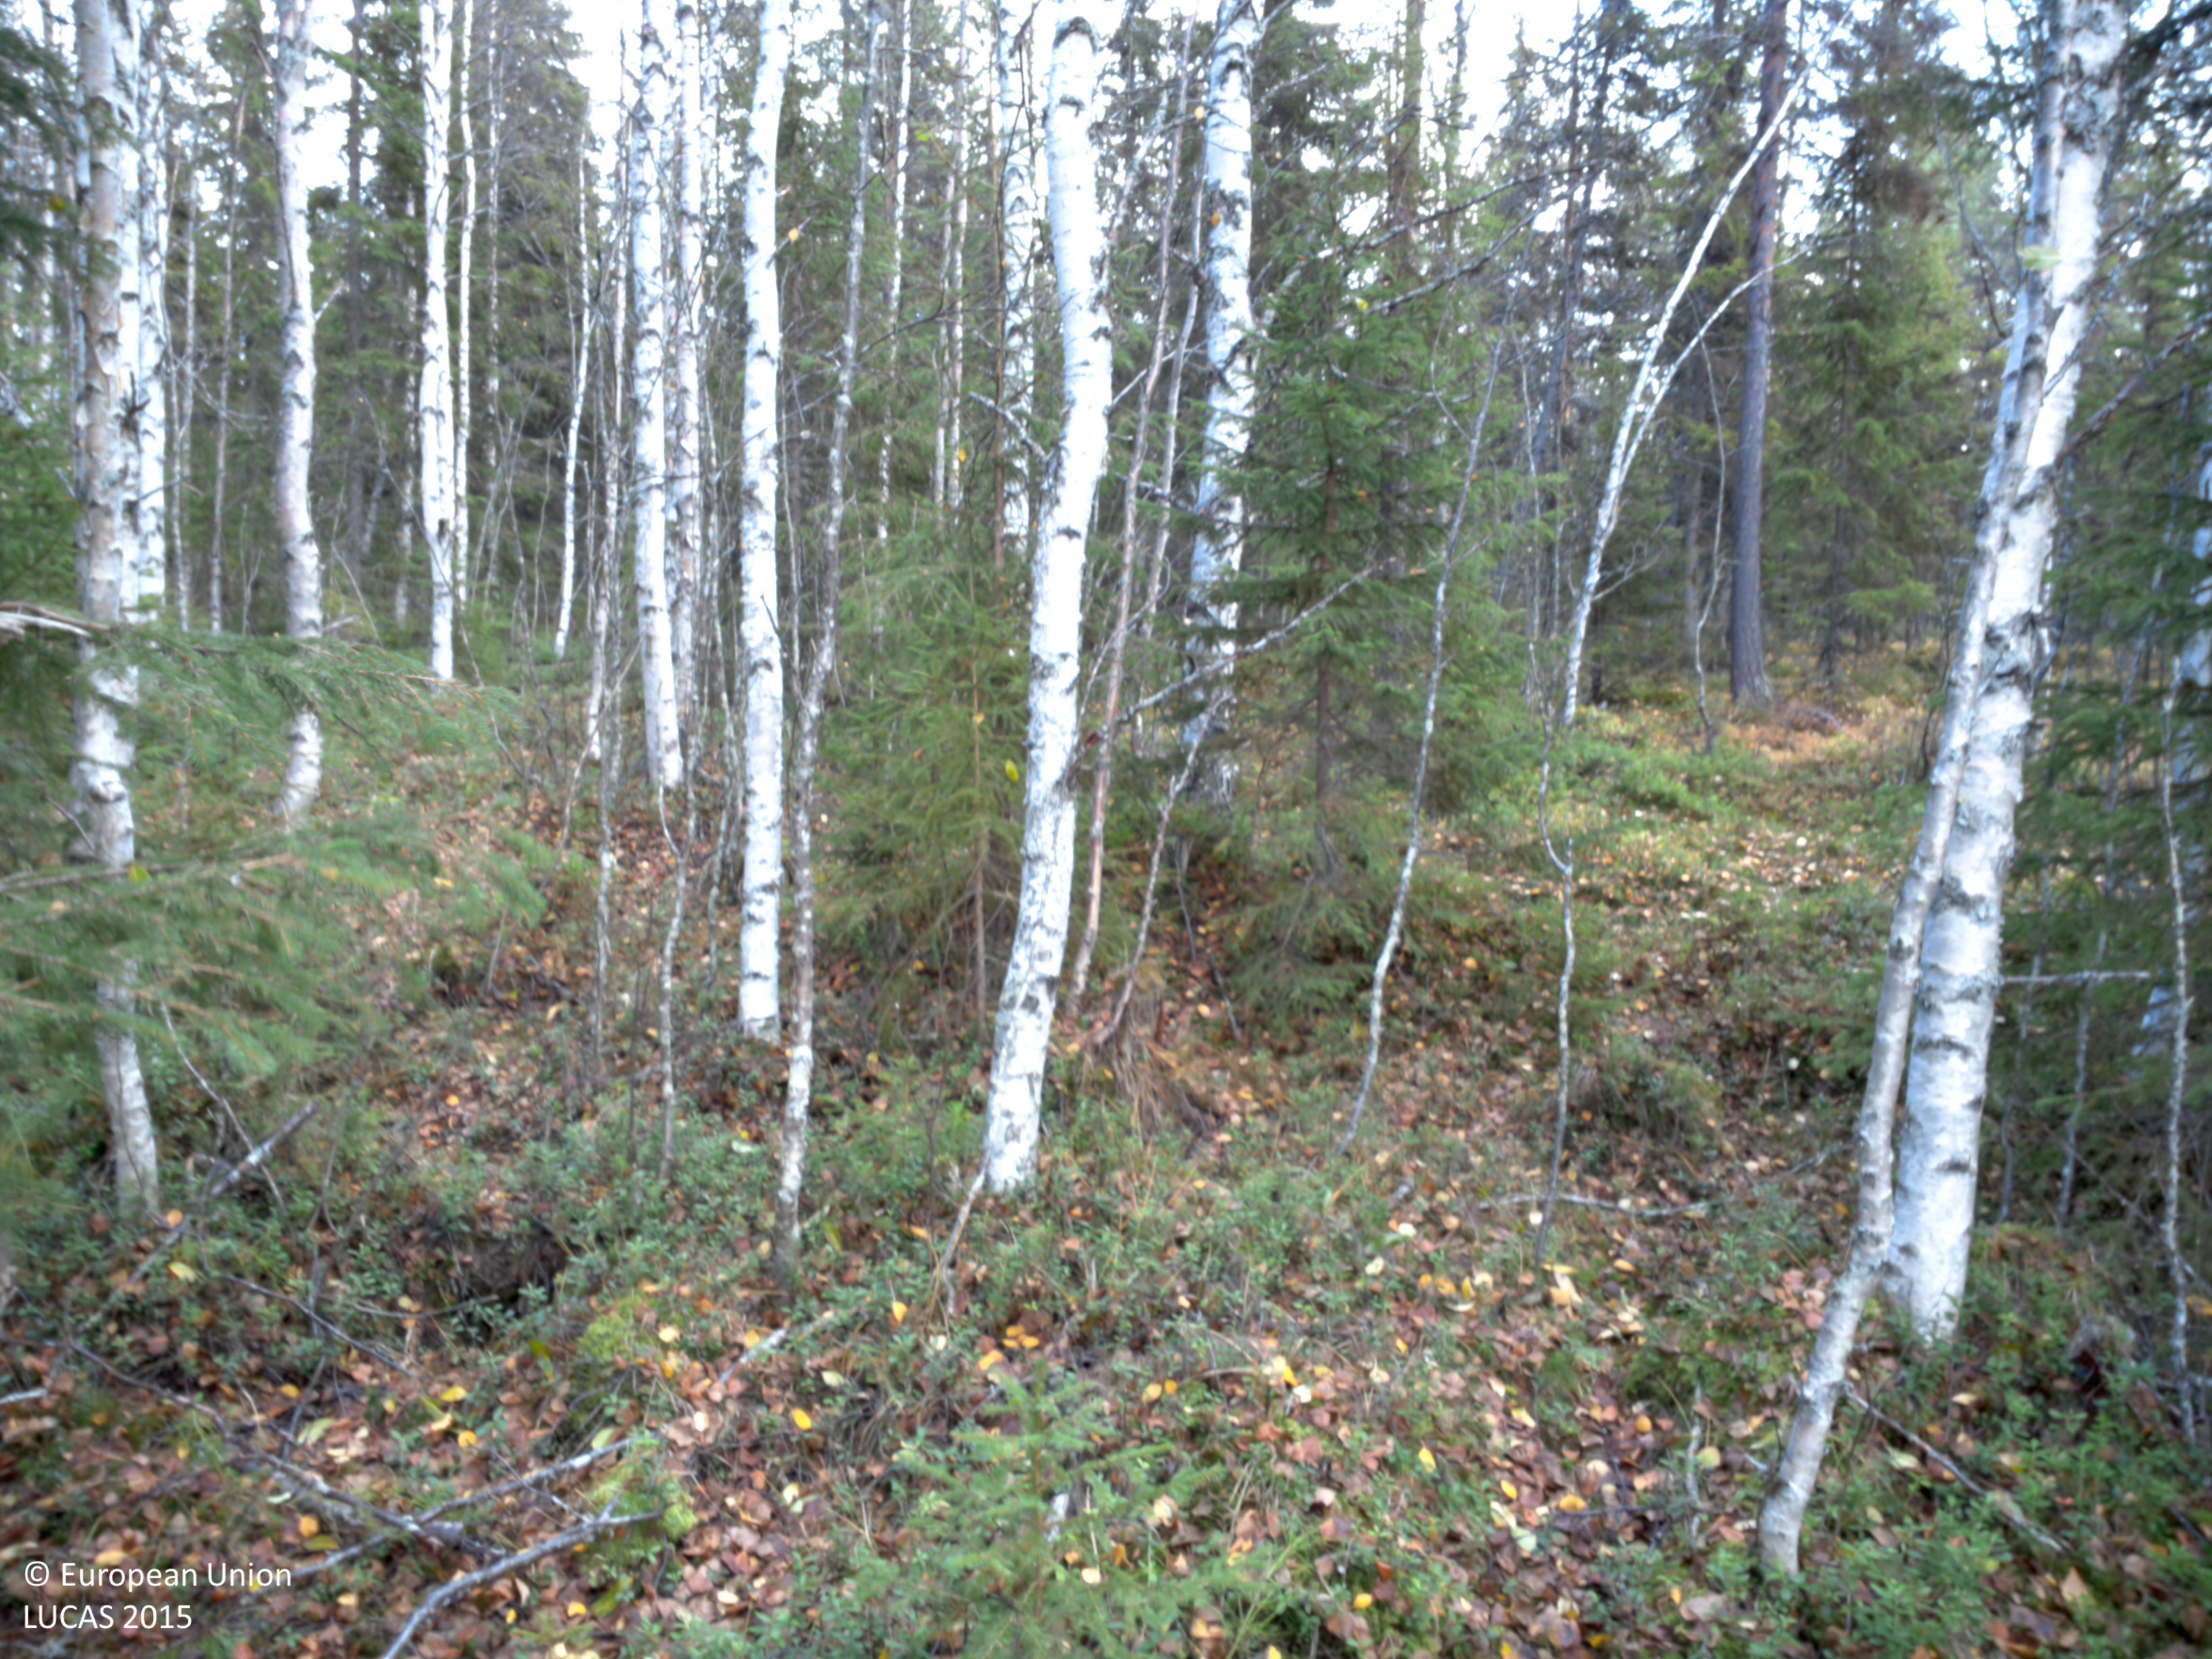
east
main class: Woodland
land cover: Spruce dominated mixed woodland
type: boreal forest
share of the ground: 50 - 75 %
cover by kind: coniferous forest trees 45 %, shrubs 30 %, broadleaved forest trees 15 %, herbaceous plants 5 %, lichens and mosses 5 %
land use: Forestry
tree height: > 5 m
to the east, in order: Spruce dominated mixed woodland; Spruce dominated coniferous woodland; Pine dominated coniferous woodland; Tracks; Pine dominated coniferous woodland; Ditches and canals; Pine dominated coniferous woodland; Tracks; Pine dominated coniferous woodland; Spruce dominated coniferous woodland
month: October
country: SE
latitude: 64.9115
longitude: 18.2291
